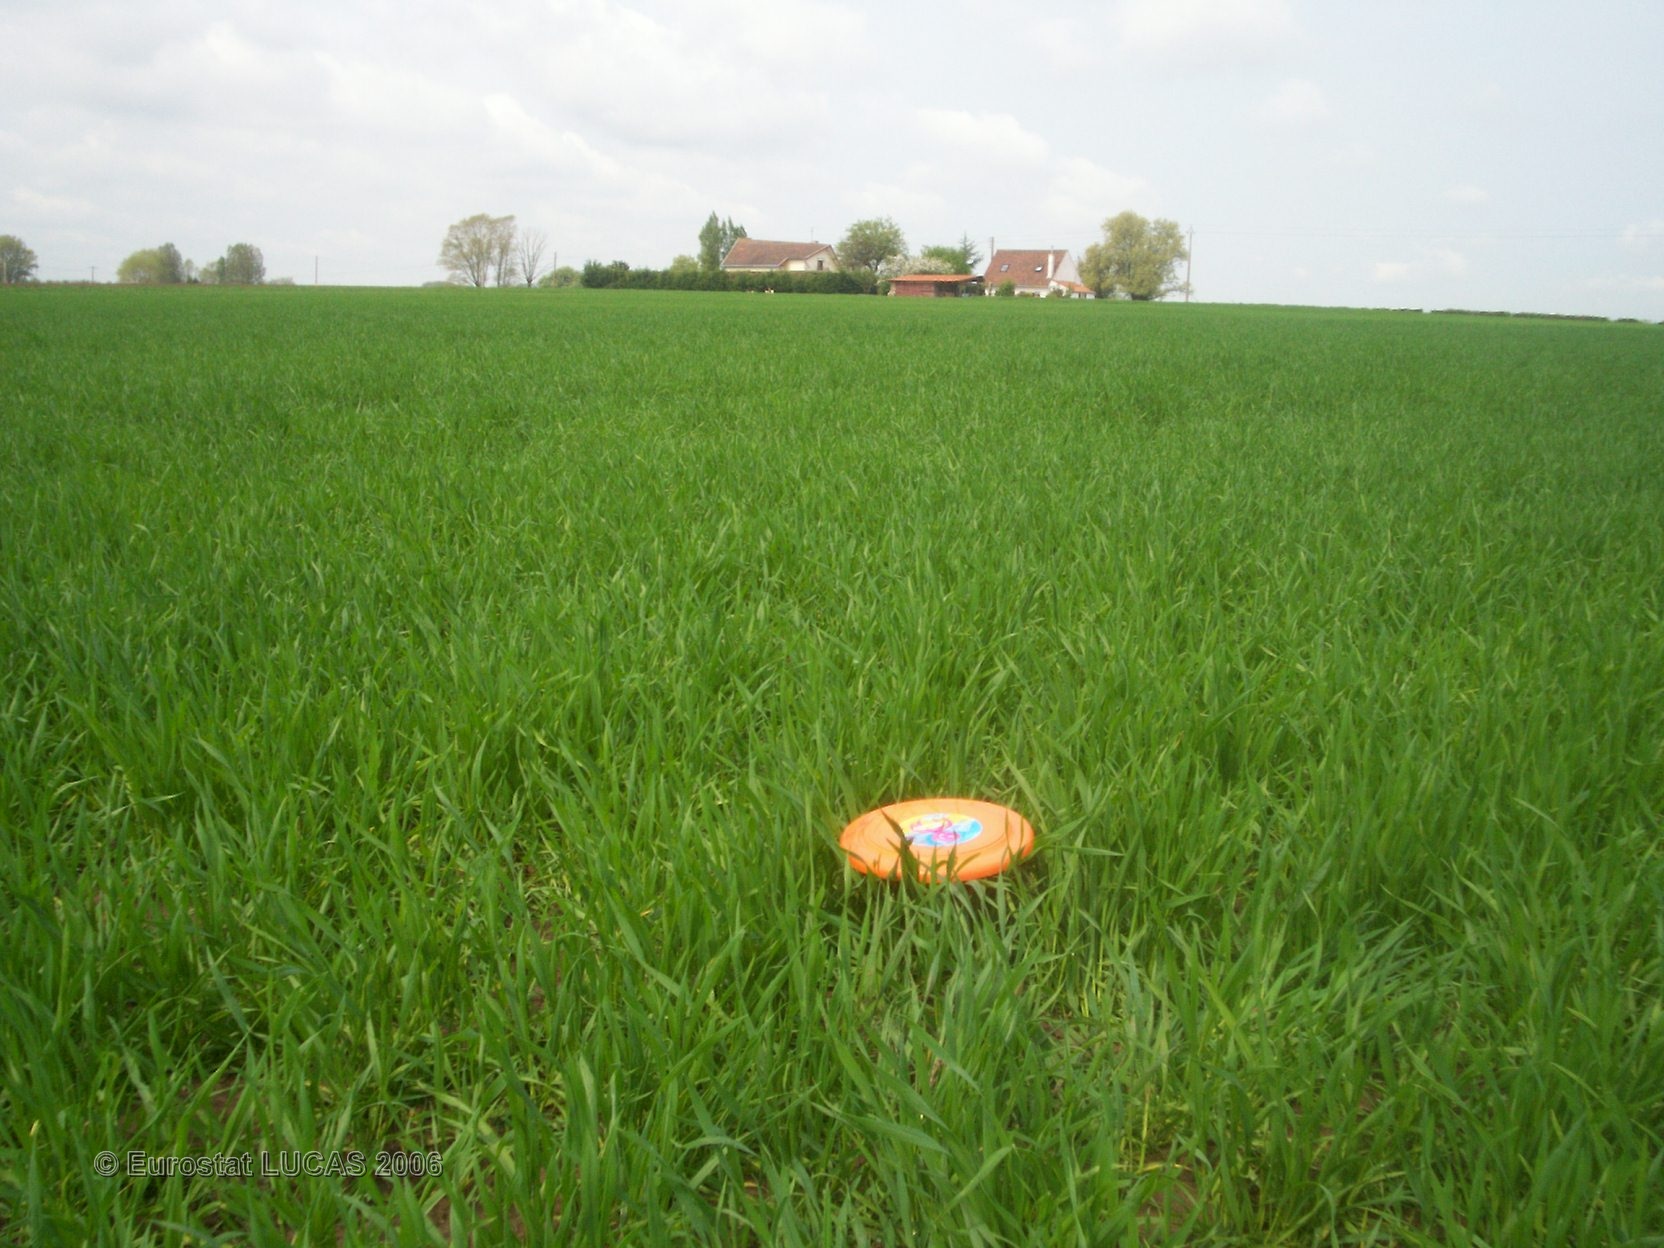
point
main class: Cropland
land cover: Common wheat
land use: Agriculture (excluding fallow land and kitchen gardens)
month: May
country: FR
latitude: 50.8987
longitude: 2.2937
